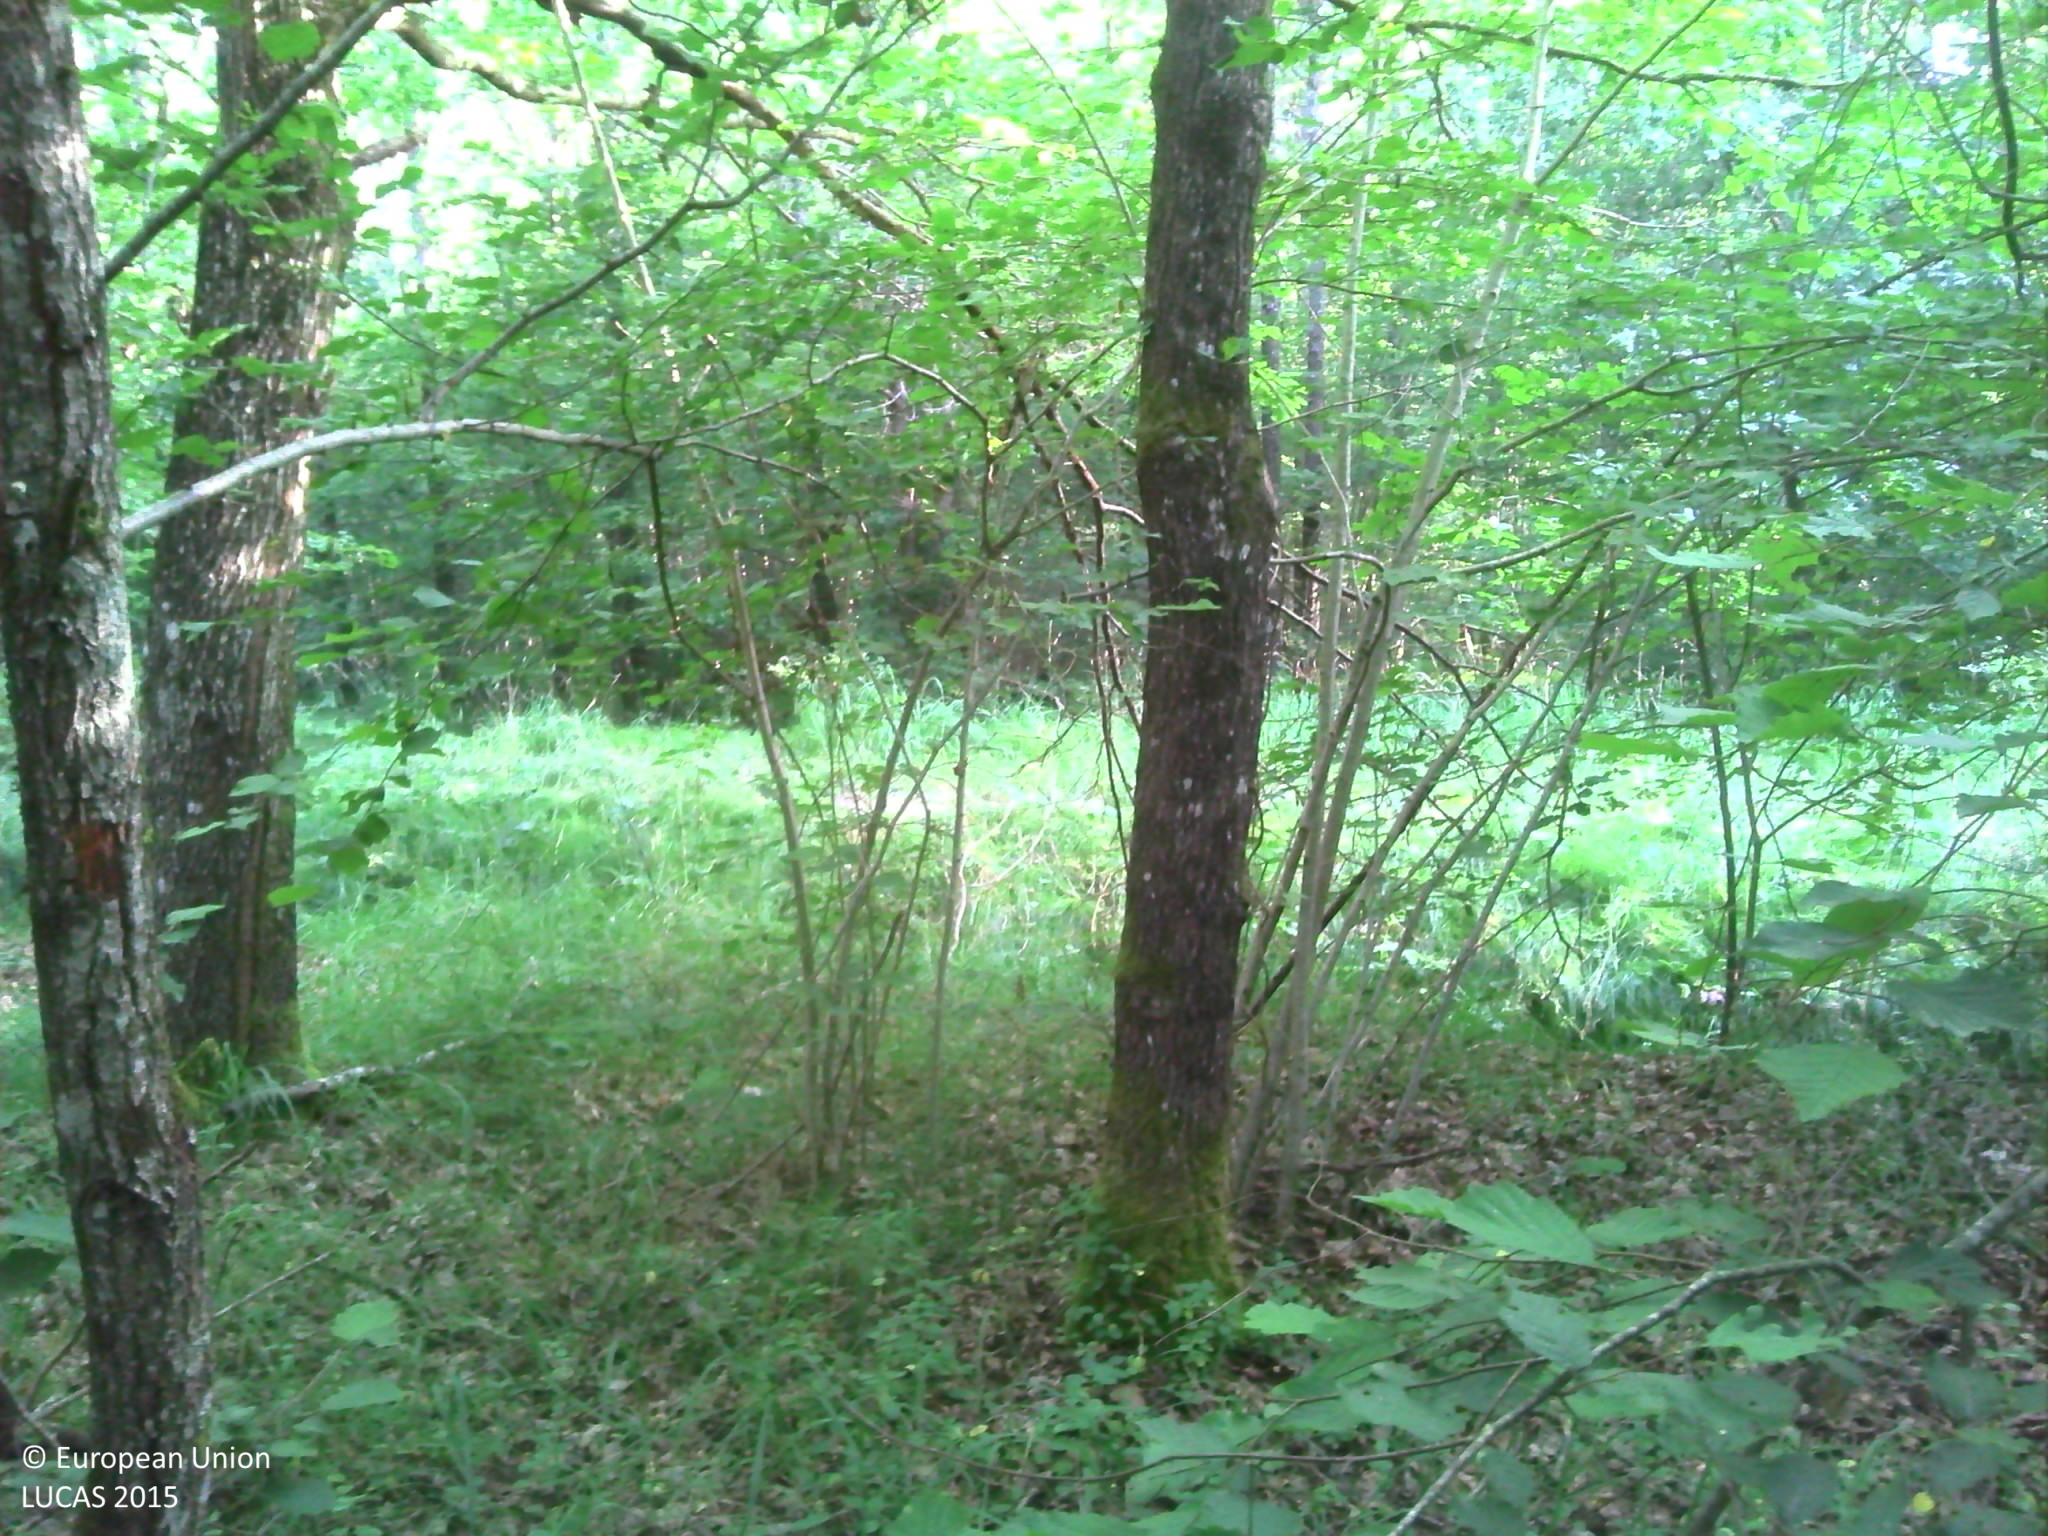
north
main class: Woodland
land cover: Broadleaved woodland
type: acidophilous oak and oak-birch forest
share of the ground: > 75 %
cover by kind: broadleaved forest trees 85 %, herbaceous plants 15 %
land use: Forestry
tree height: > 5 m
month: July
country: FR
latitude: 46.9844
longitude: 5.2289
